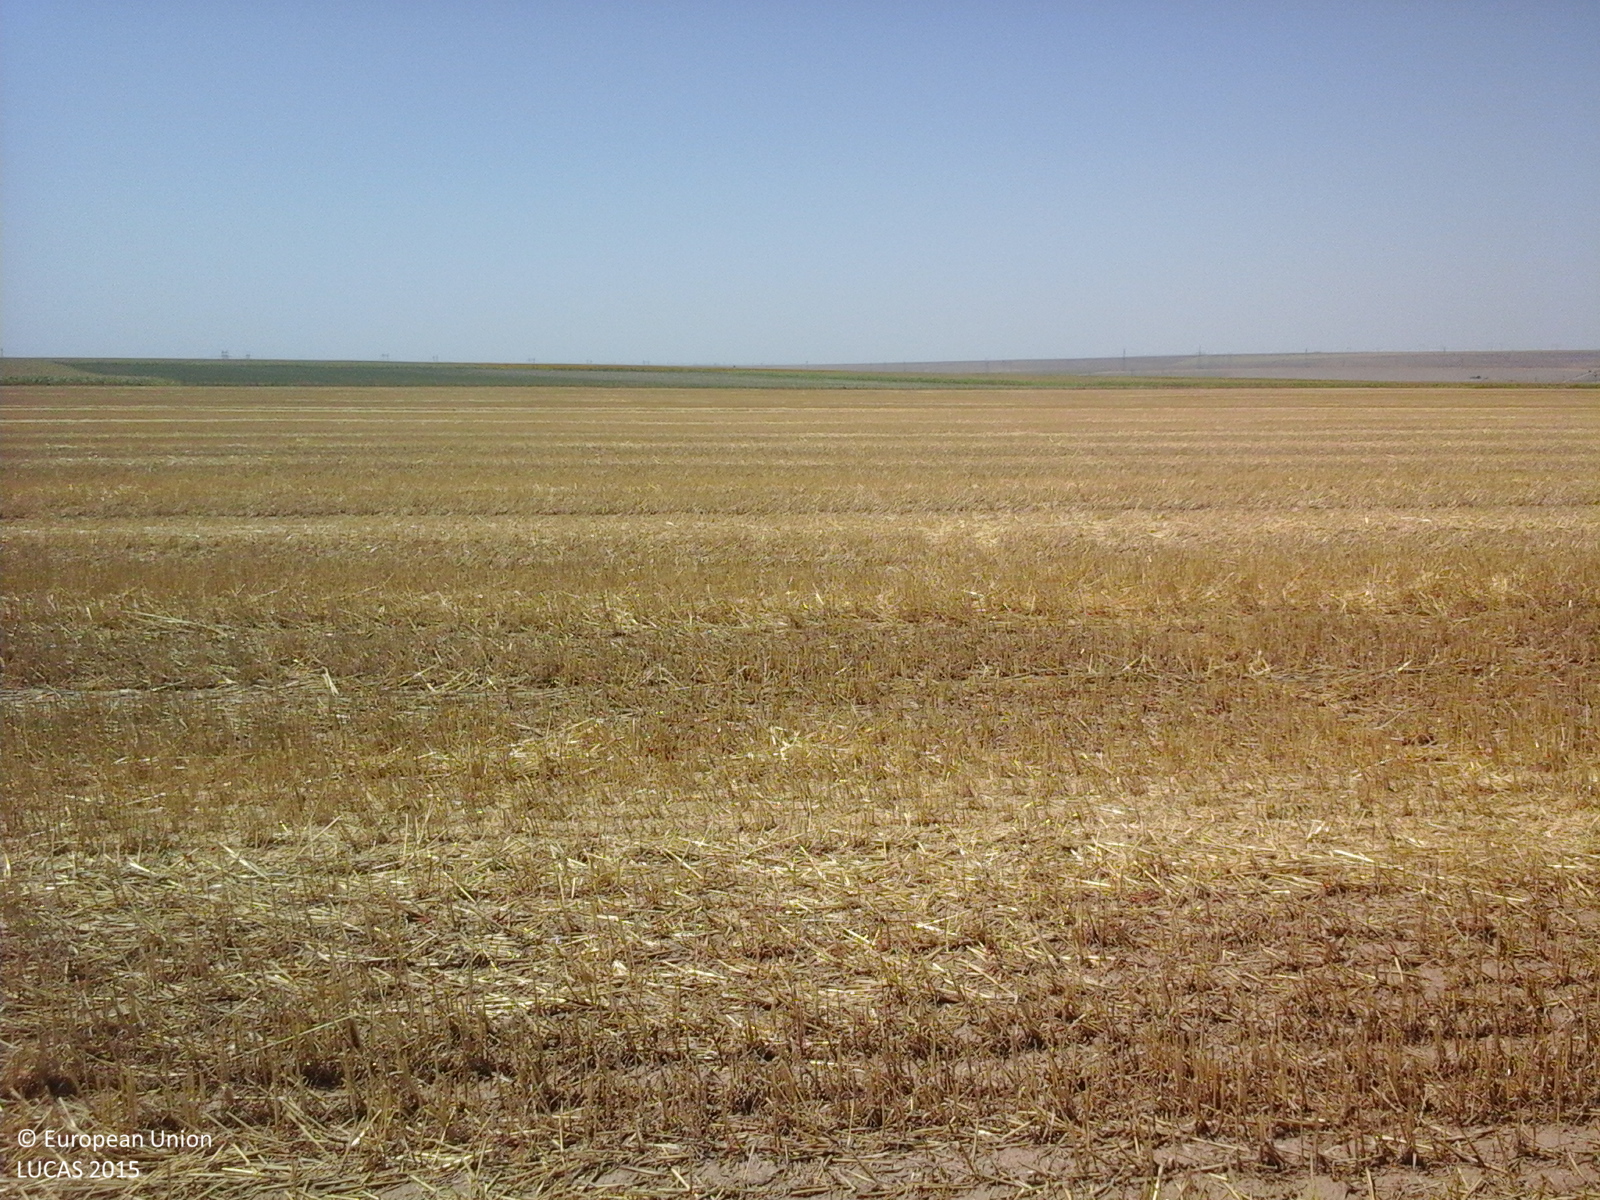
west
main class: Cropland
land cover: Common wheat
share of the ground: 50 - 75 %
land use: Agriculture (excluding fallow land and kitchen gardens)
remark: Harvested field
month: August
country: RO
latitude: 44.4721
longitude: 28.2292
